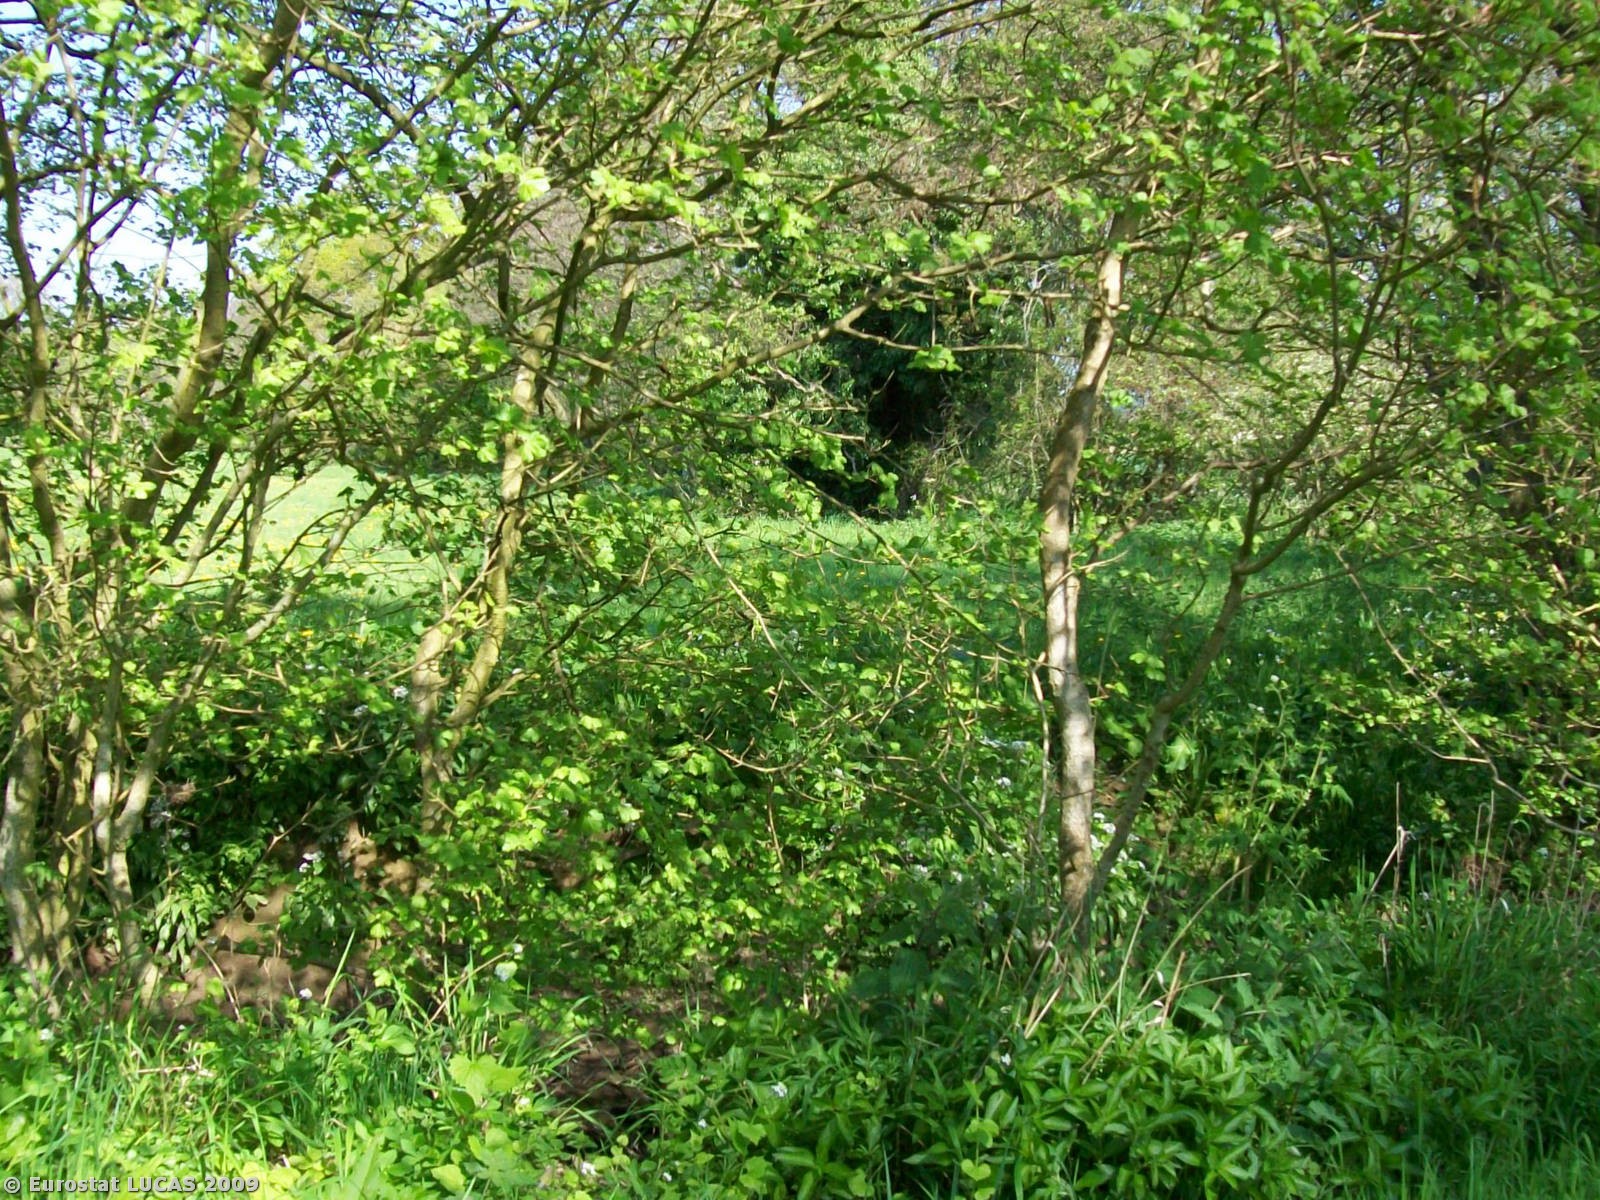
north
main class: Grassland
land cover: Grassland without tree/shrub cover
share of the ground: > 75 %
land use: Agriculture (excluding fallow land and kitchen gardens)
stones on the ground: < 10 %
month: May
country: GB
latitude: 51.0235
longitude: 0.3473
